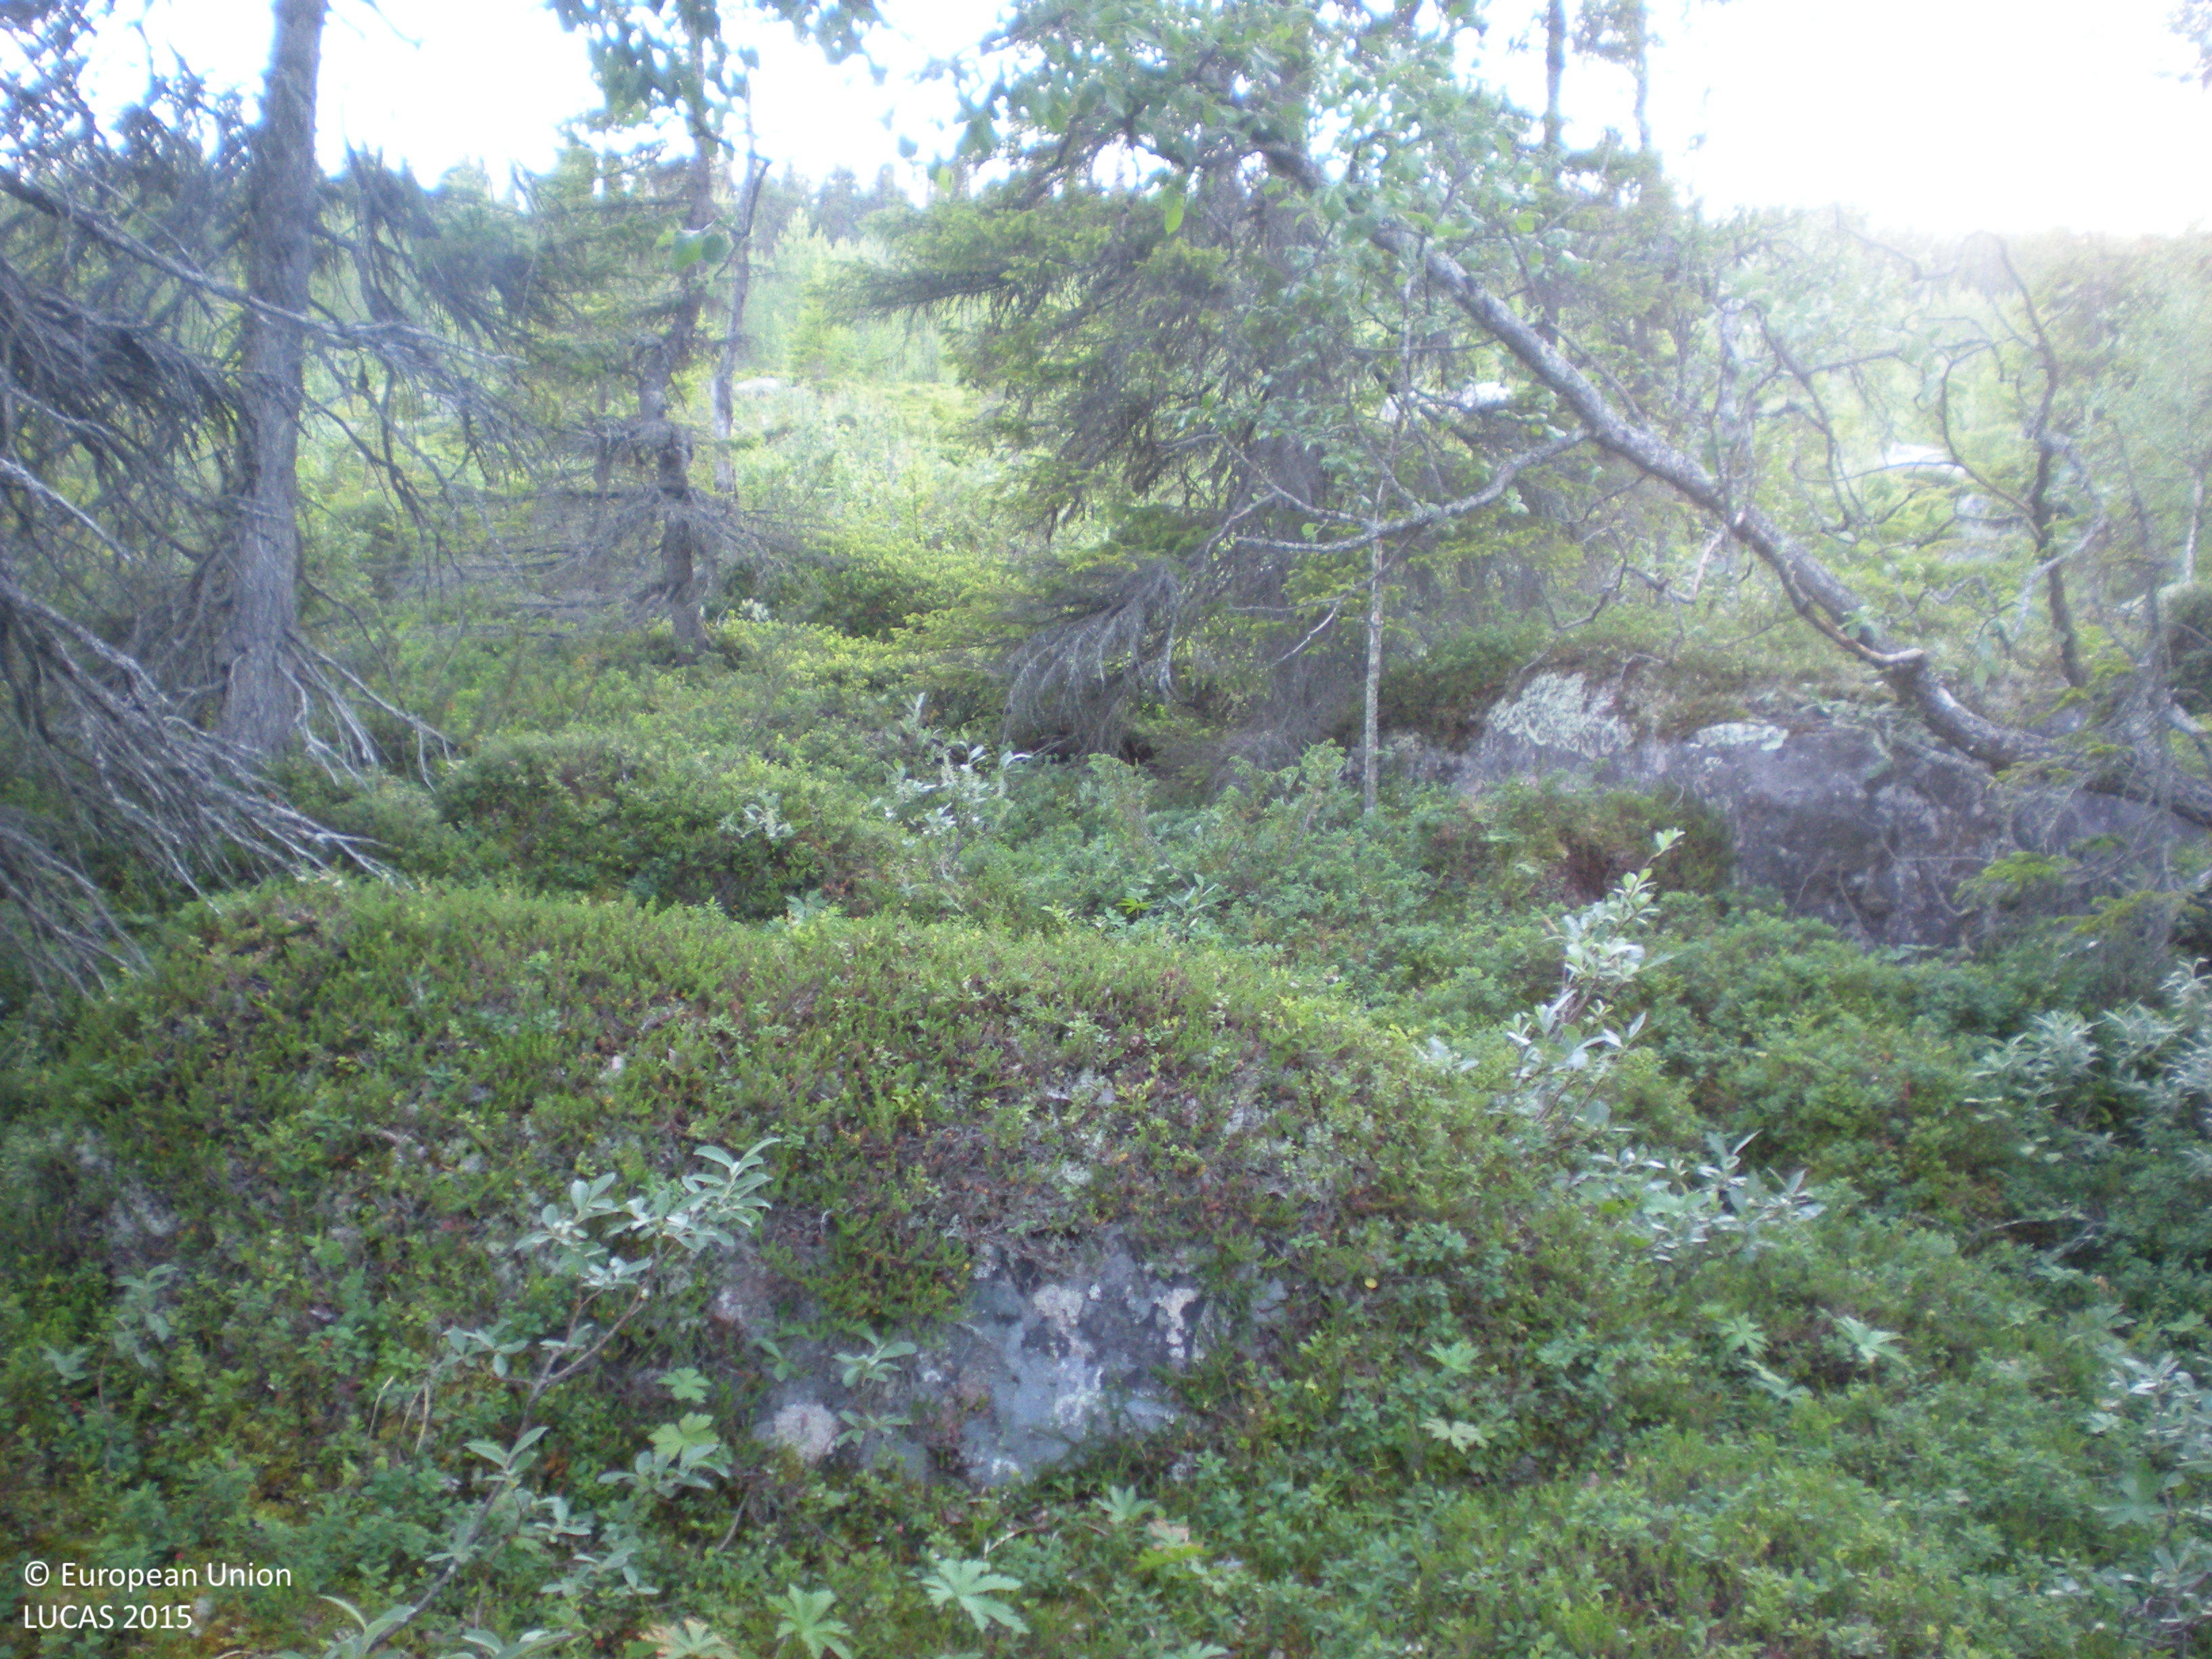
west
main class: Woodland
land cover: Spruce dominated mixed woodland
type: boreal forest
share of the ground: 50 - 75 %
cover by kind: coniferous forest trees 50 %, broadleaved forest trees 20 %, shrubs 20 %, herbaceous plants 5 %, lichens and mosses 5 %
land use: Forestry
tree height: > 5 m
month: August
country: SE
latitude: 66.2872
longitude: 17.9977
